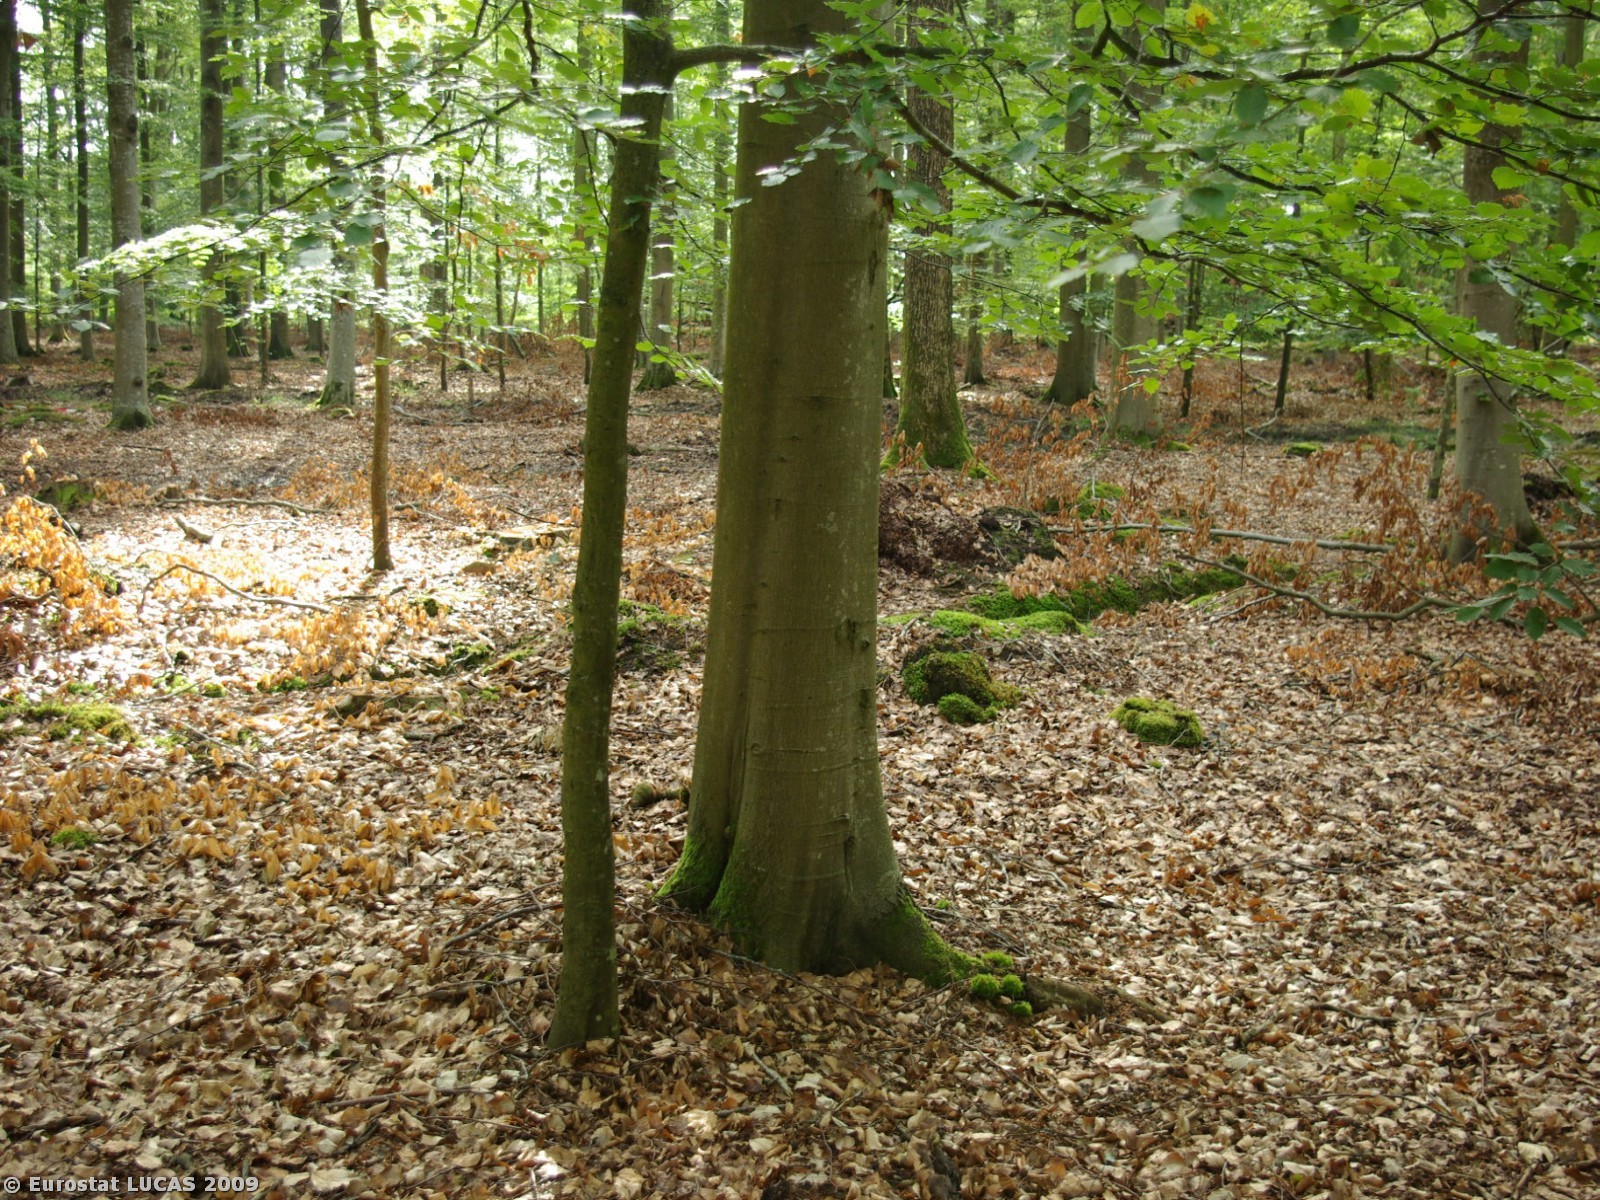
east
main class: Woodland
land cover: Broadleaved woodland
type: beech forest
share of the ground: > 75 %
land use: Forestry
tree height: > 5 m
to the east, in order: Broadleaved woodland; Ditches and canals; Broadleaved woodland; Ditches and canals; Broadleaved woodland; Ditches and canals; Broadleaved woodland; Ditches and canals; Broadleaved woodland; Ditches and canals; Broadleaved woodland; Ditches and canals; Broadleaved woodland; Ditches and canals; Tracks; Broadleaved woodland; Ditches and canals; Tracks; Ditches and canals; Broadleaved woodland; Grassland without tree/shrub cover; Shruby margins; Inland water bodies
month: July
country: DK
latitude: 54.9600
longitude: 8.8296
